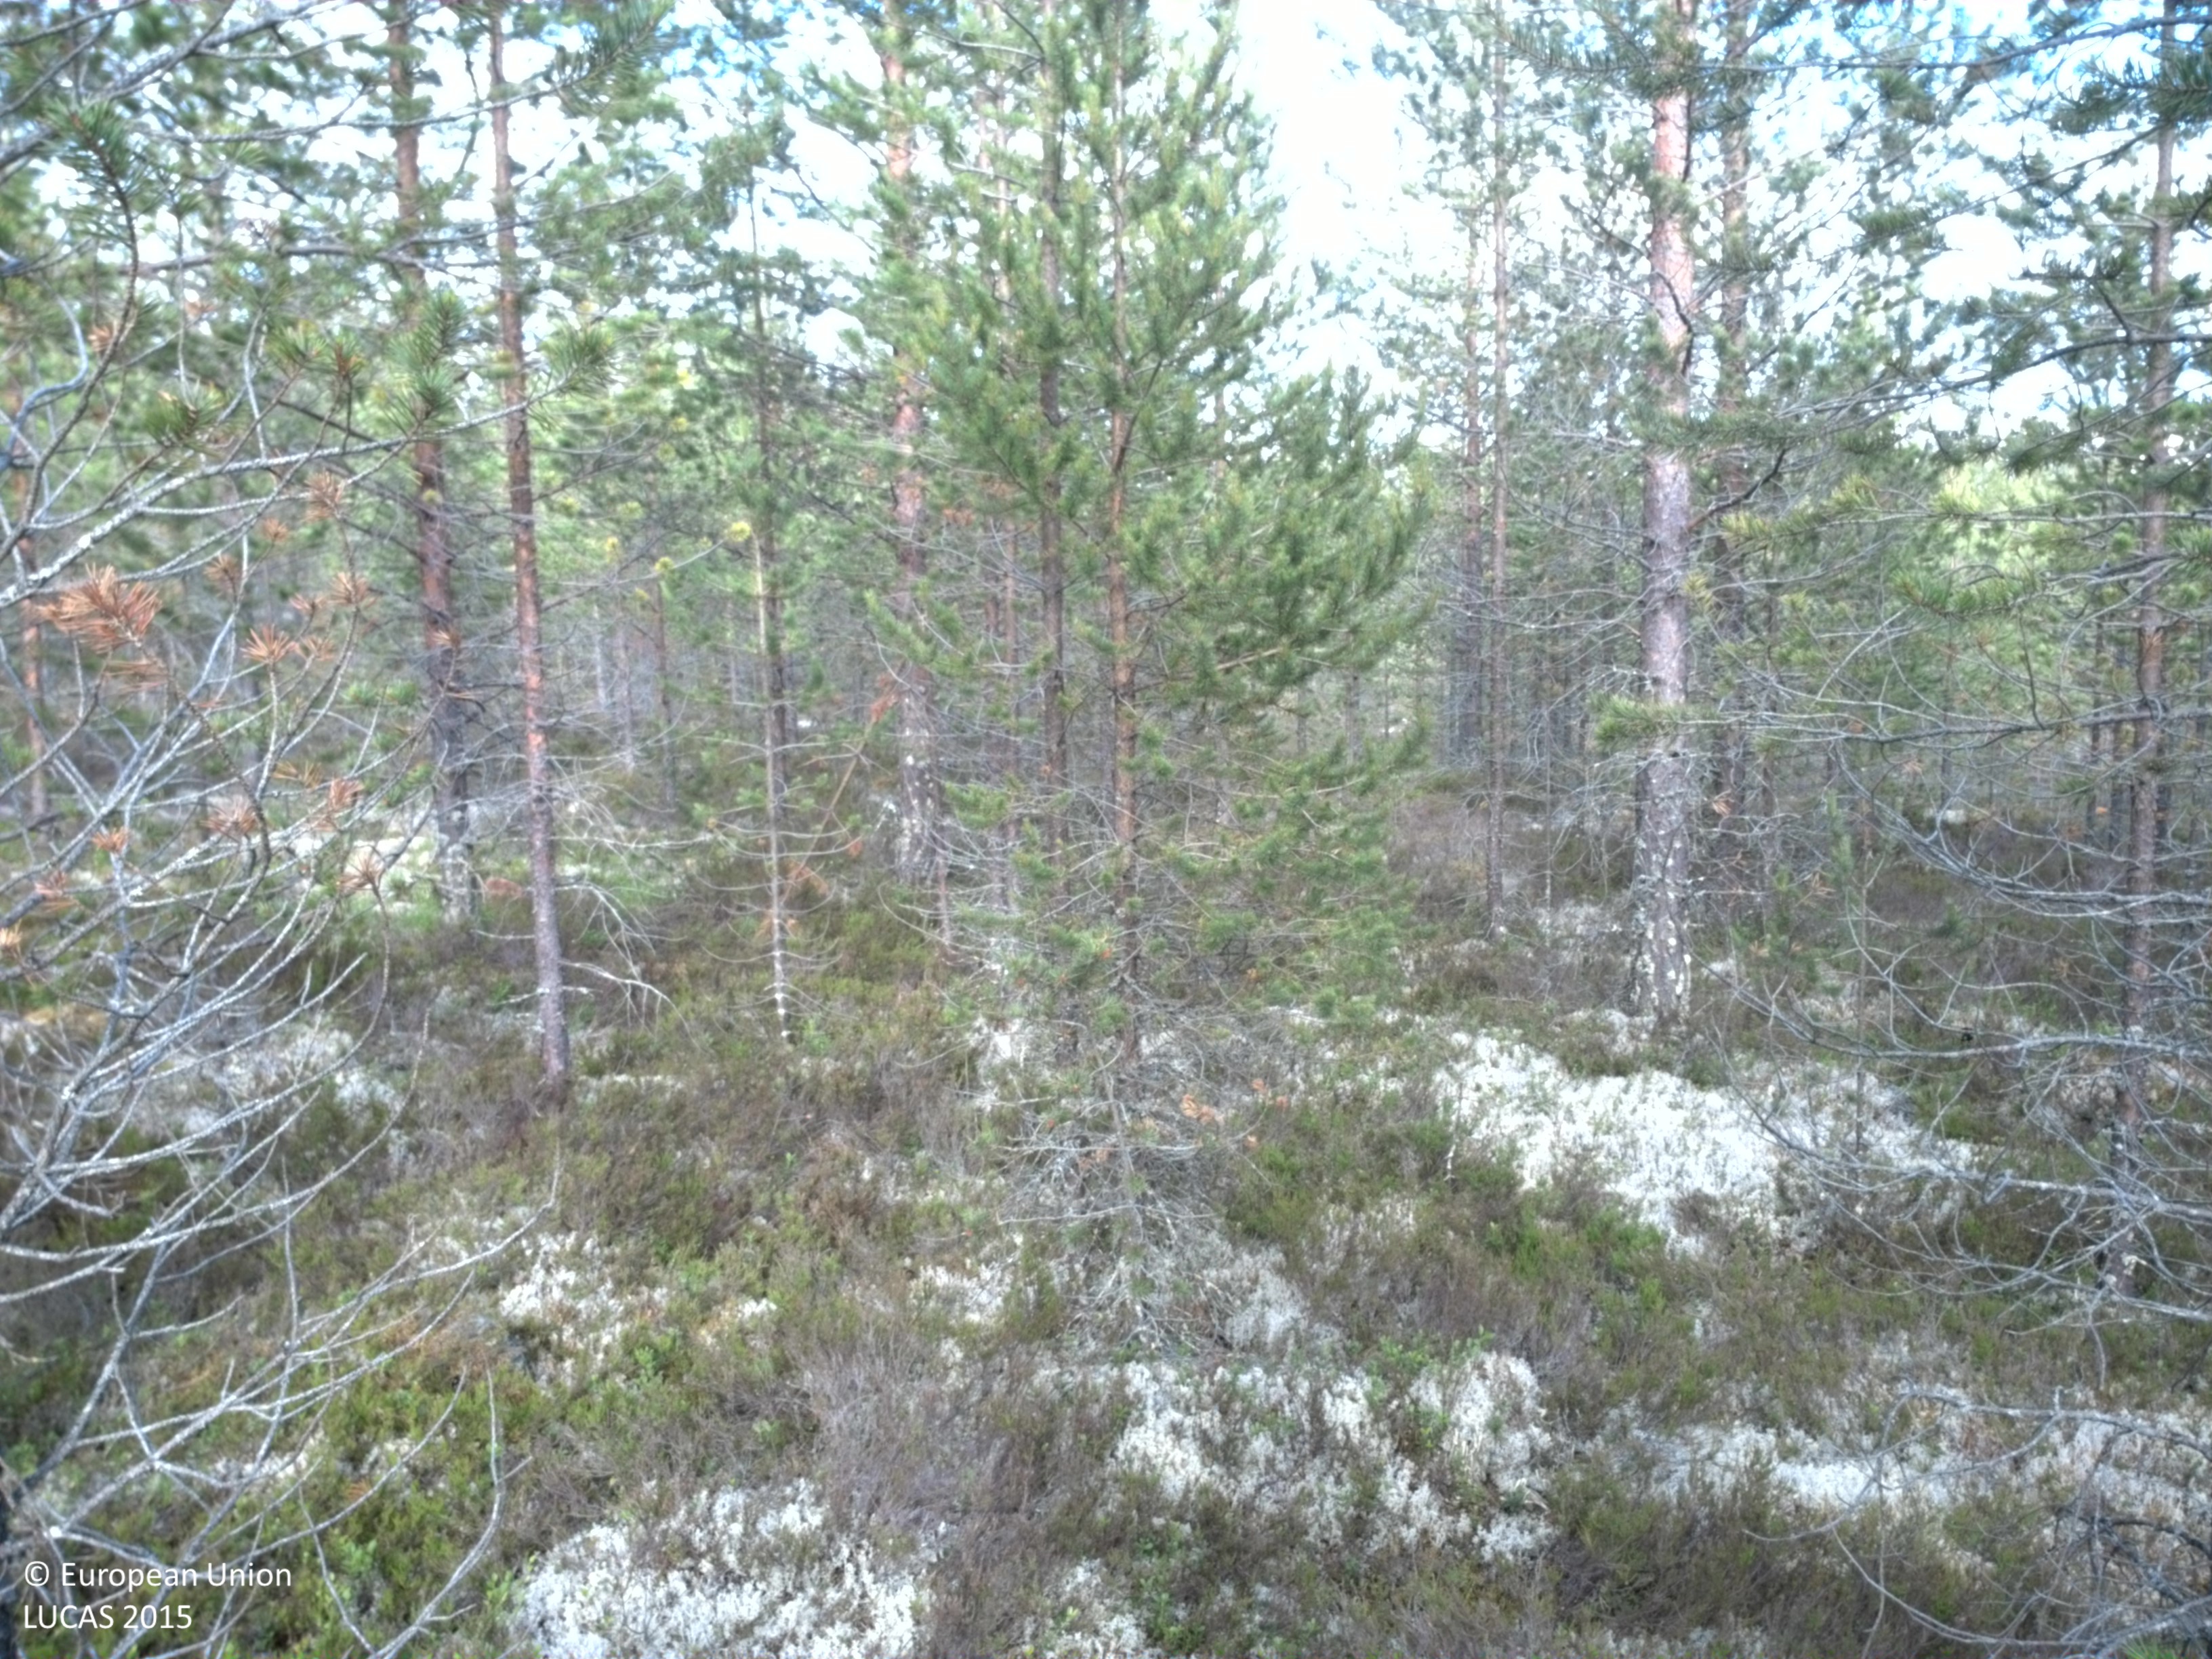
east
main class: Woodland
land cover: Pine dominated coniferous woodland
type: boreal forest
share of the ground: 50 - 75 %
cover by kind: coniferous forest trees 60 %, shrubs 20 %, lichens and mosses 20 %
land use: Forestry
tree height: < 5 m
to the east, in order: Pine dominated coniferous woodland
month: July
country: SE
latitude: 61.5045
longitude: 13.6133
